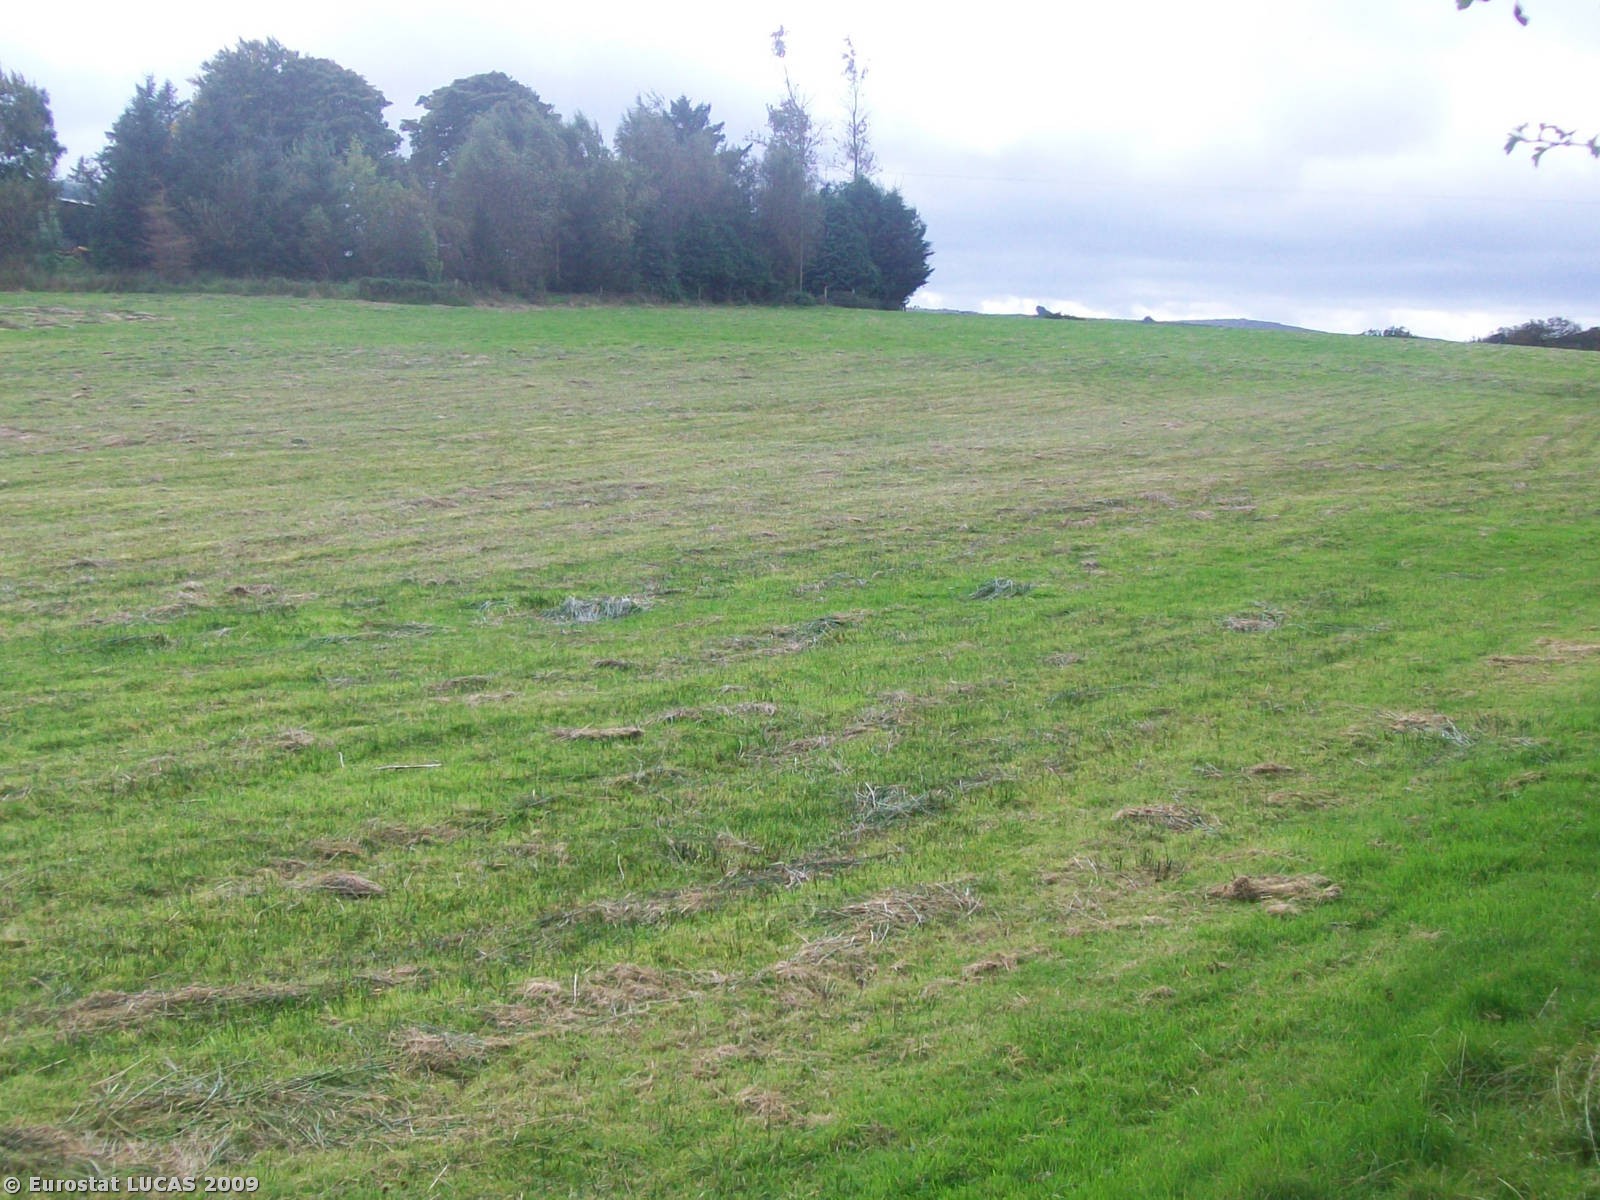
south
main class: Grassland
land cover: Grassland without tree/shrub cover
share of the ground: > 75 %
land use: Agriculture (excluding fallow land and kitchen gardens)
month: September
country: IE
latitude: 54.0859
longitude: -8.3635
